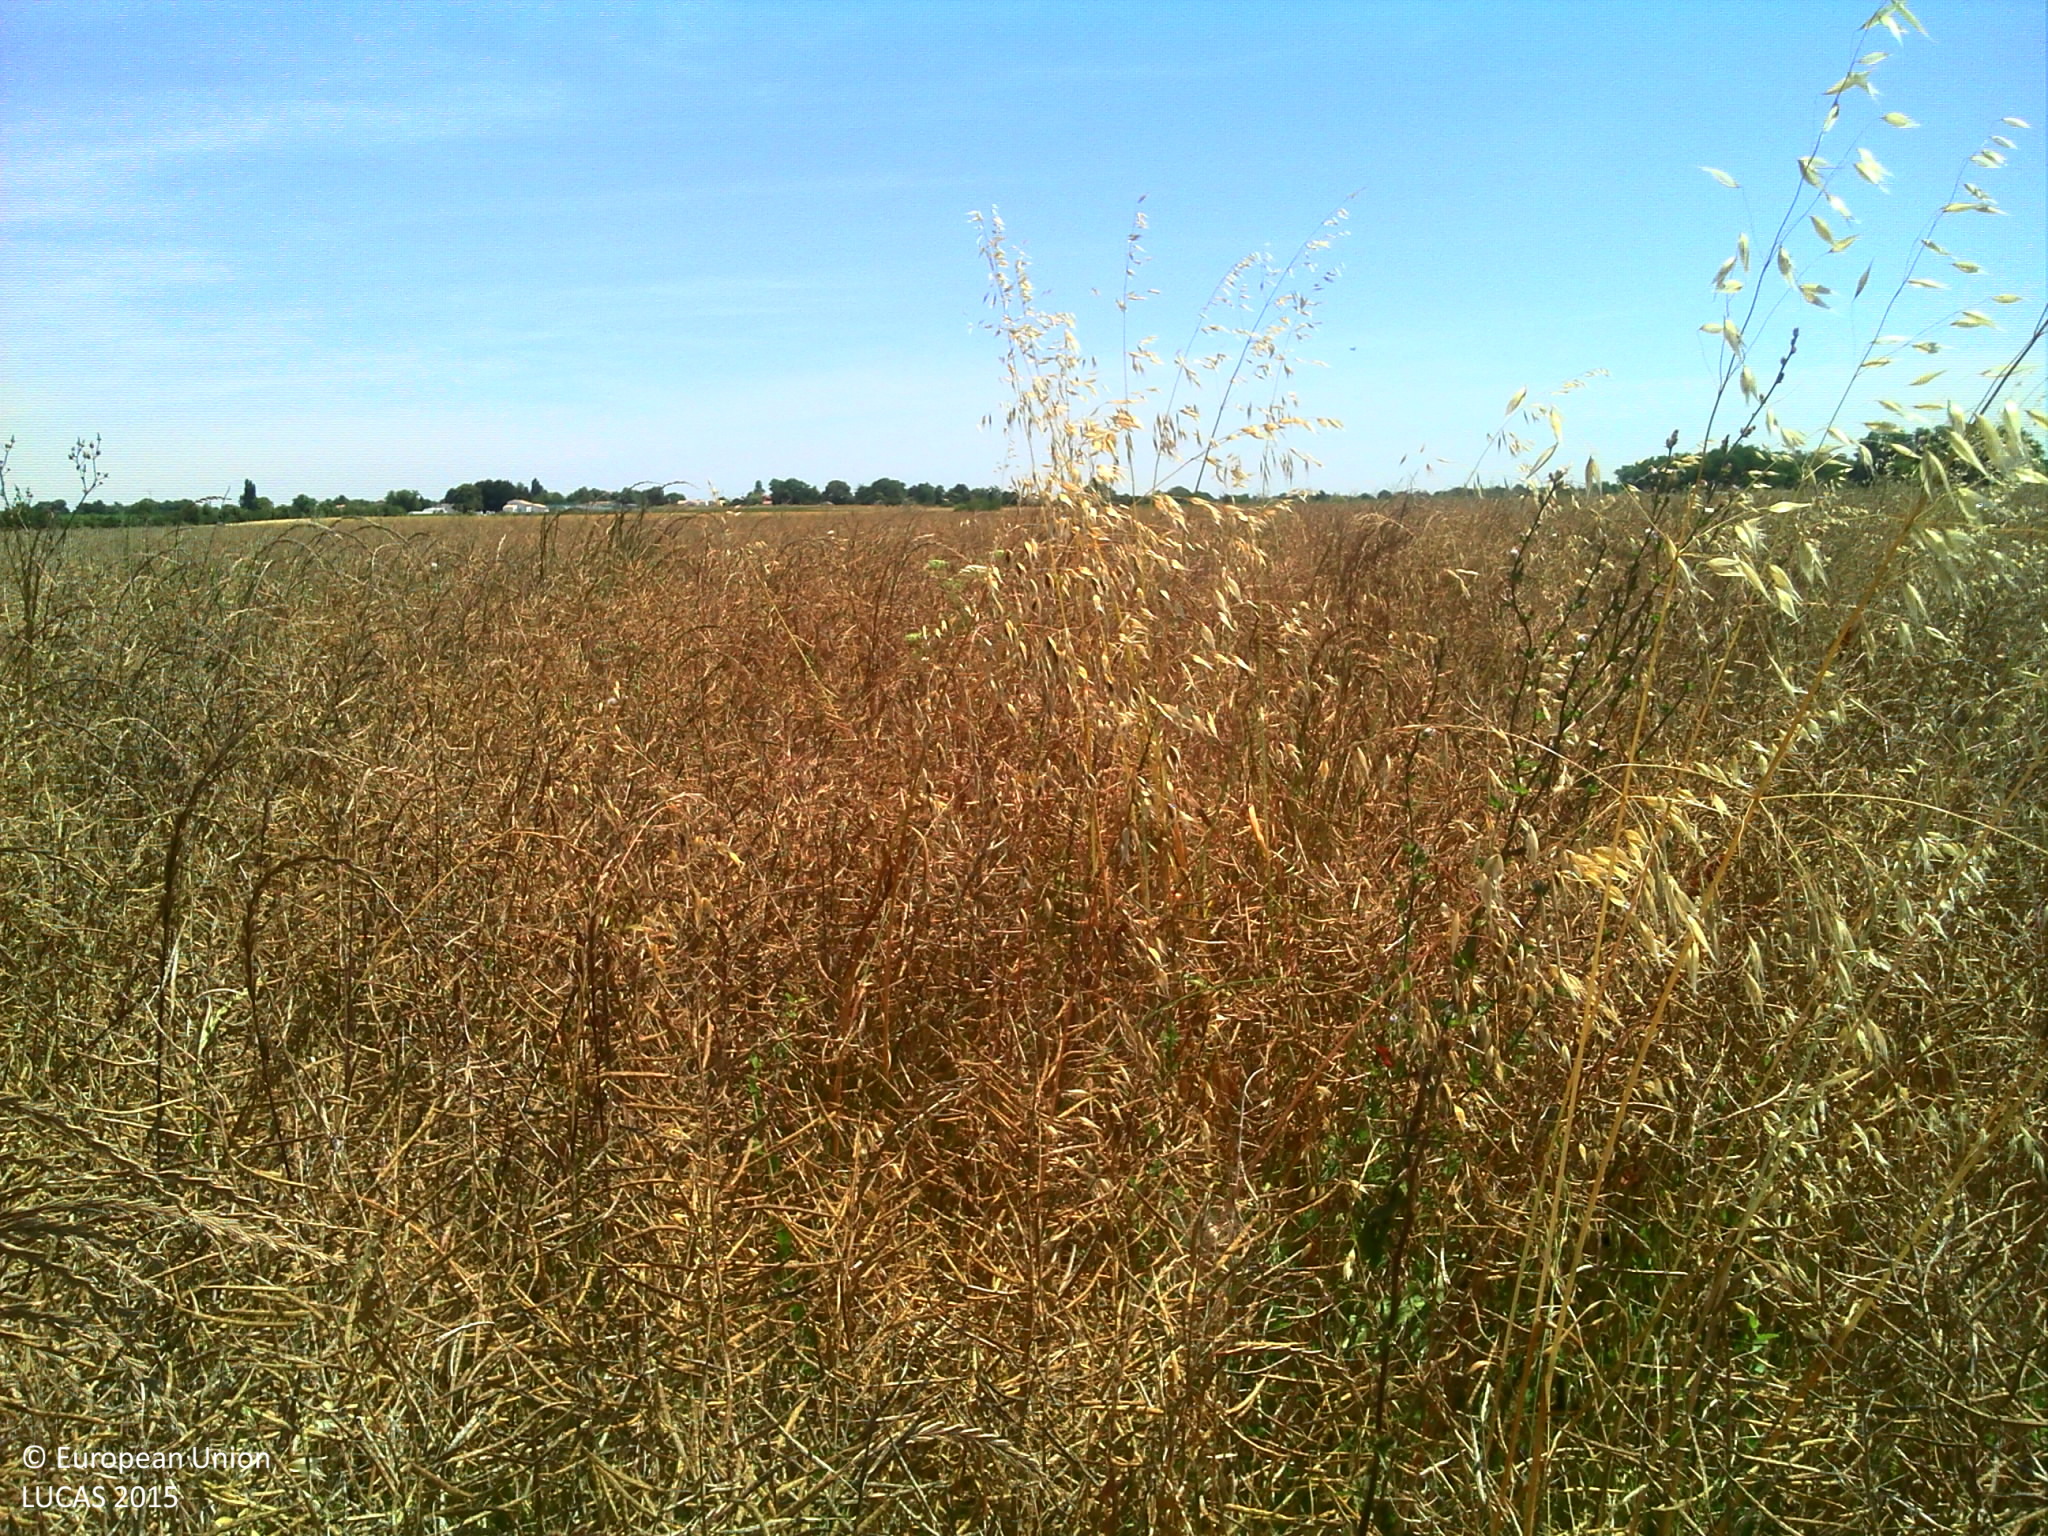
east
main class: Cropland
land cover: Rape and turnip rape
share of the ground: > 75 %
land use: Agriculture (excluding fallow land and kitchen gardens)
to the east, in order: Rape and turnip rape; Grass margins; Tracks; Grass margins; Durum wheat
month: June
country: FR
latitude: 45.7215
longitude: -0.8833
